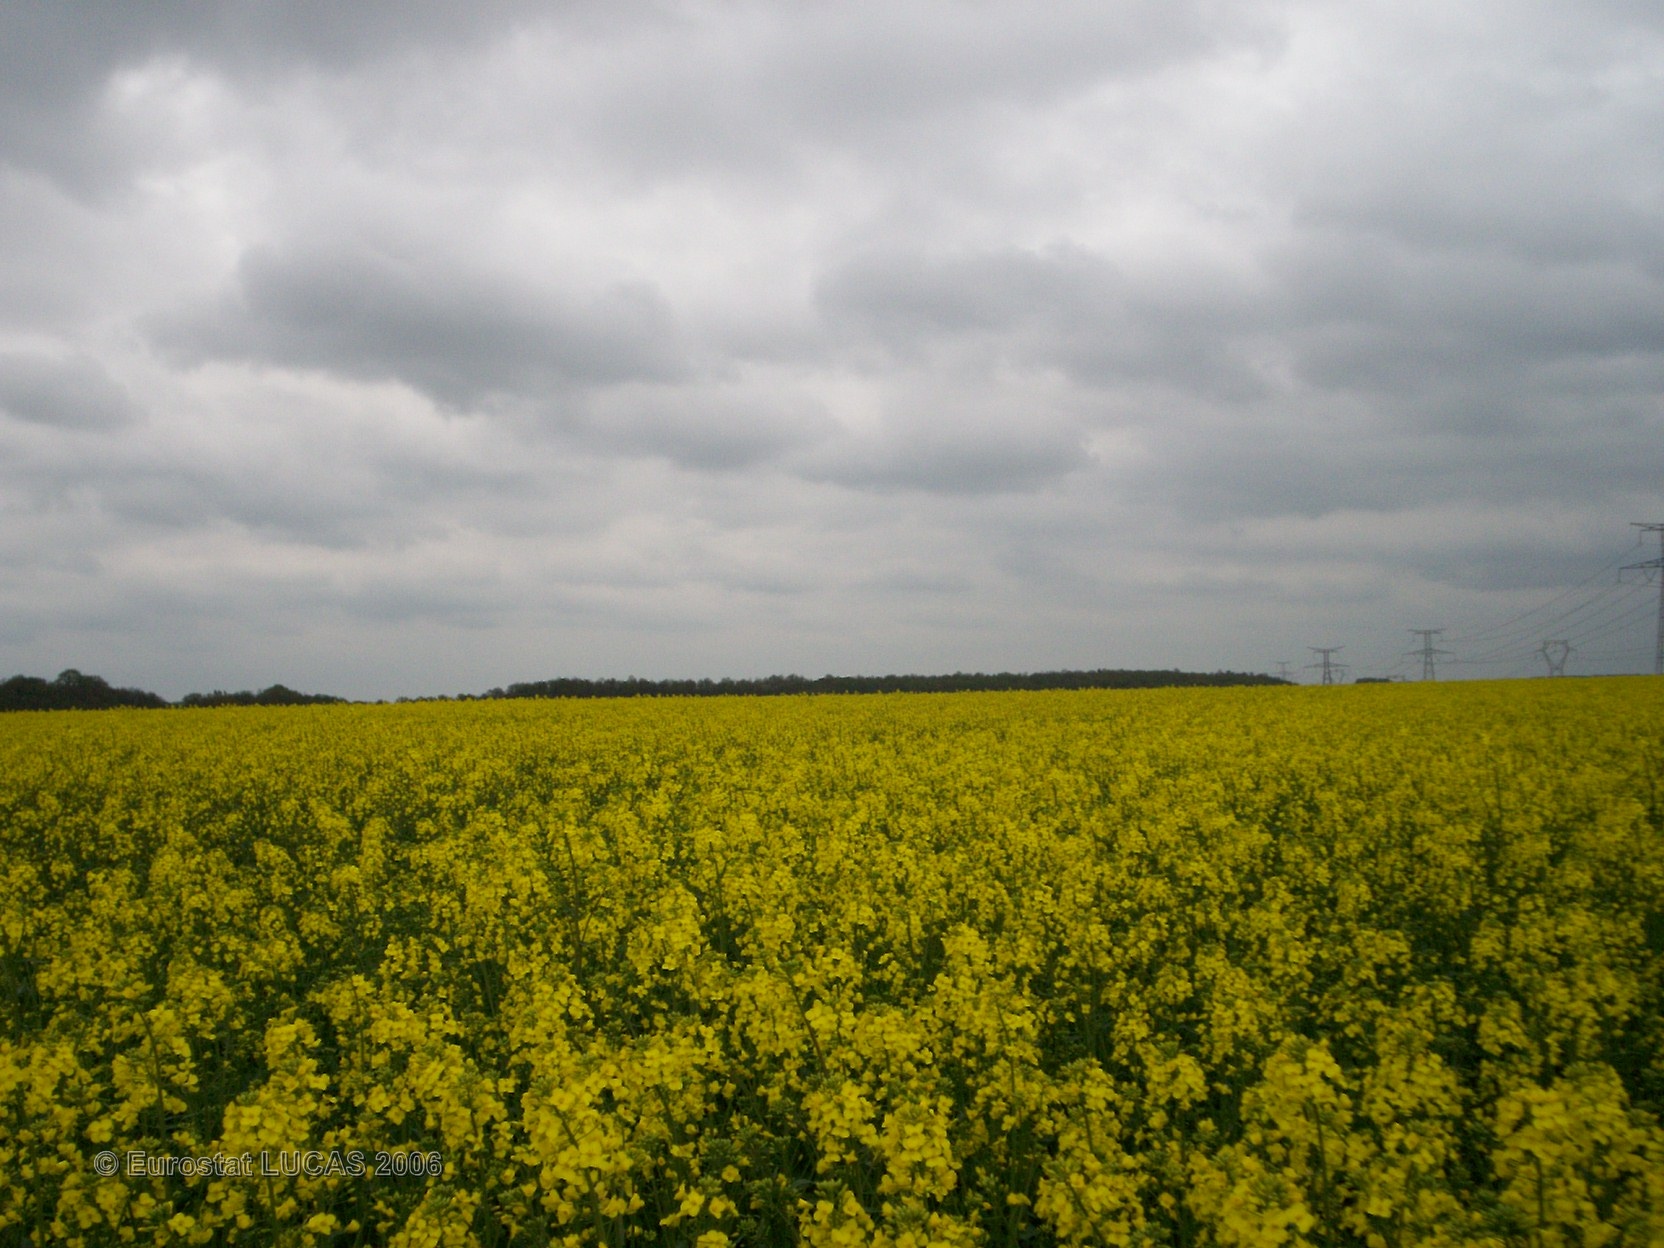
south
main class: Cropland
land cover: Rape and turnip rape
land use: Agriculture (excluding fallow land and kitchen gardens)
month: May
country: FR
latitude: 48.1541
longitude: 2.8539
